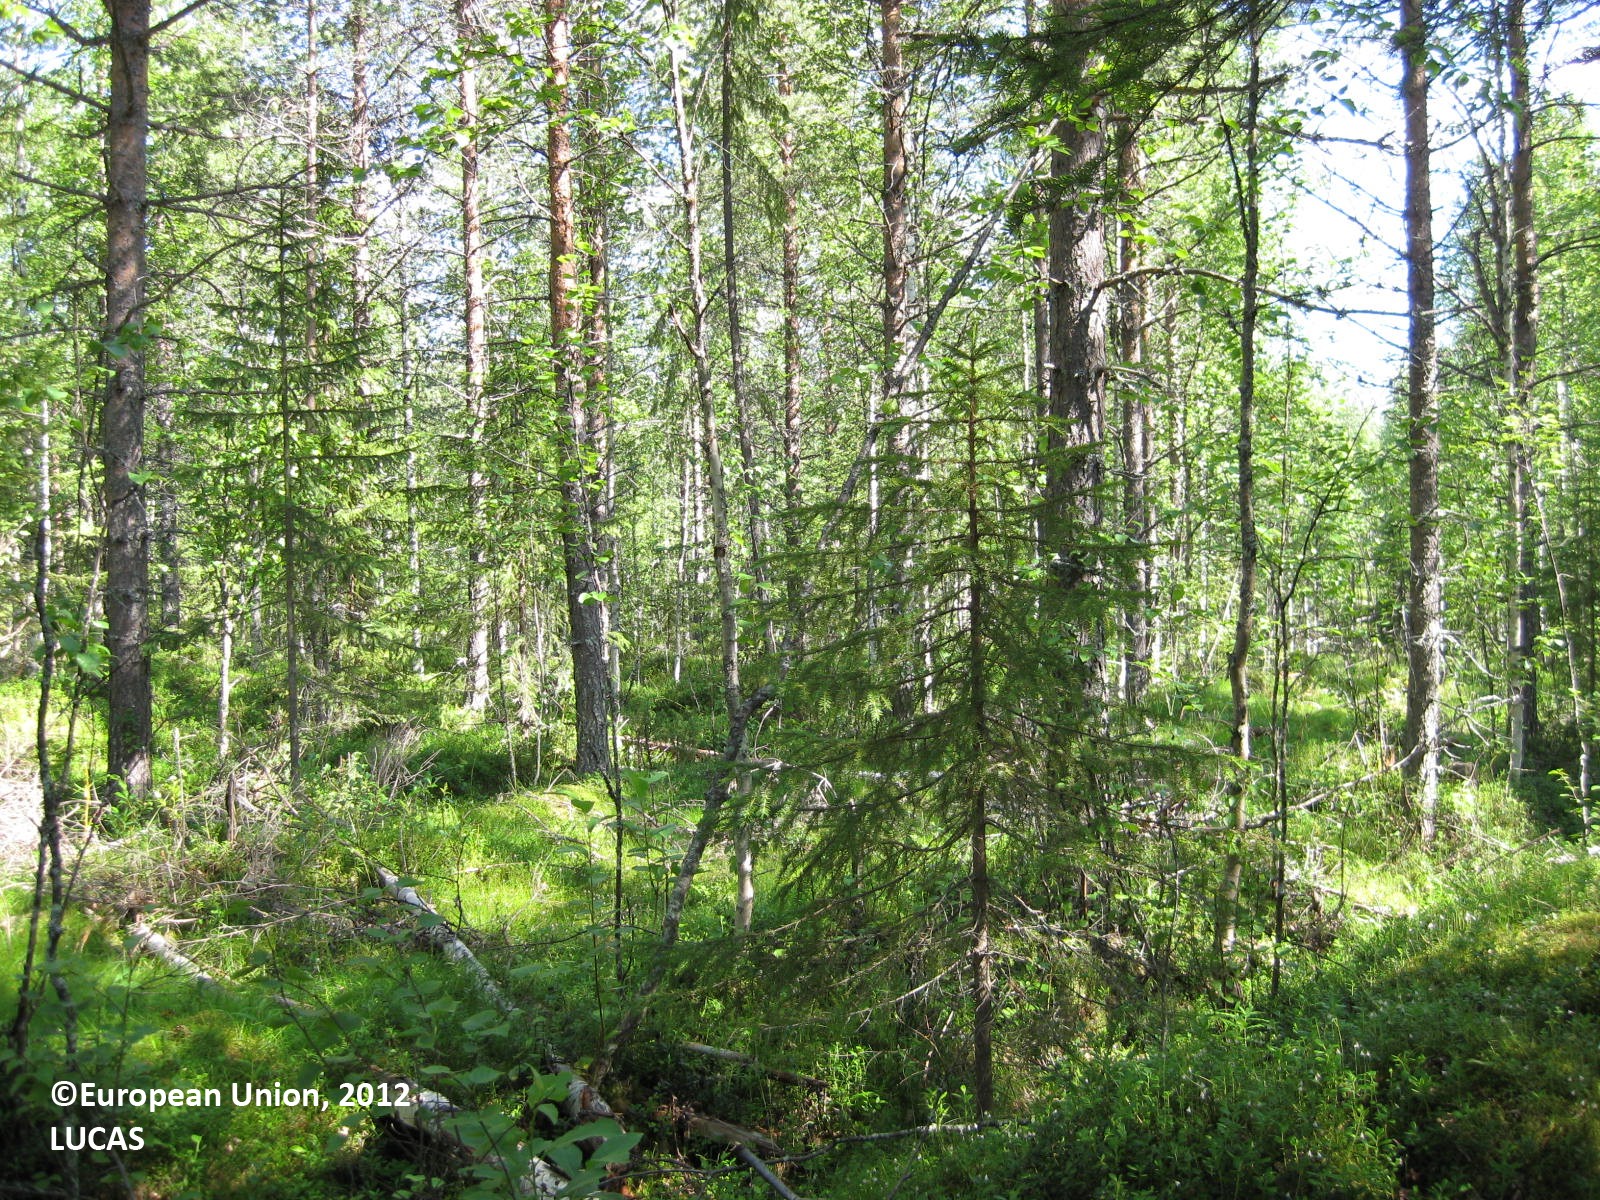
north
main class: Woodland
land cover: Pine dominated mixed woodland
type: boreal forest
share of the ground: 50 - 75 %
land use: Forestry
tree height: > 5 m
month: July
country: FI
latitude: 65.5775
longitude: 28.4753
